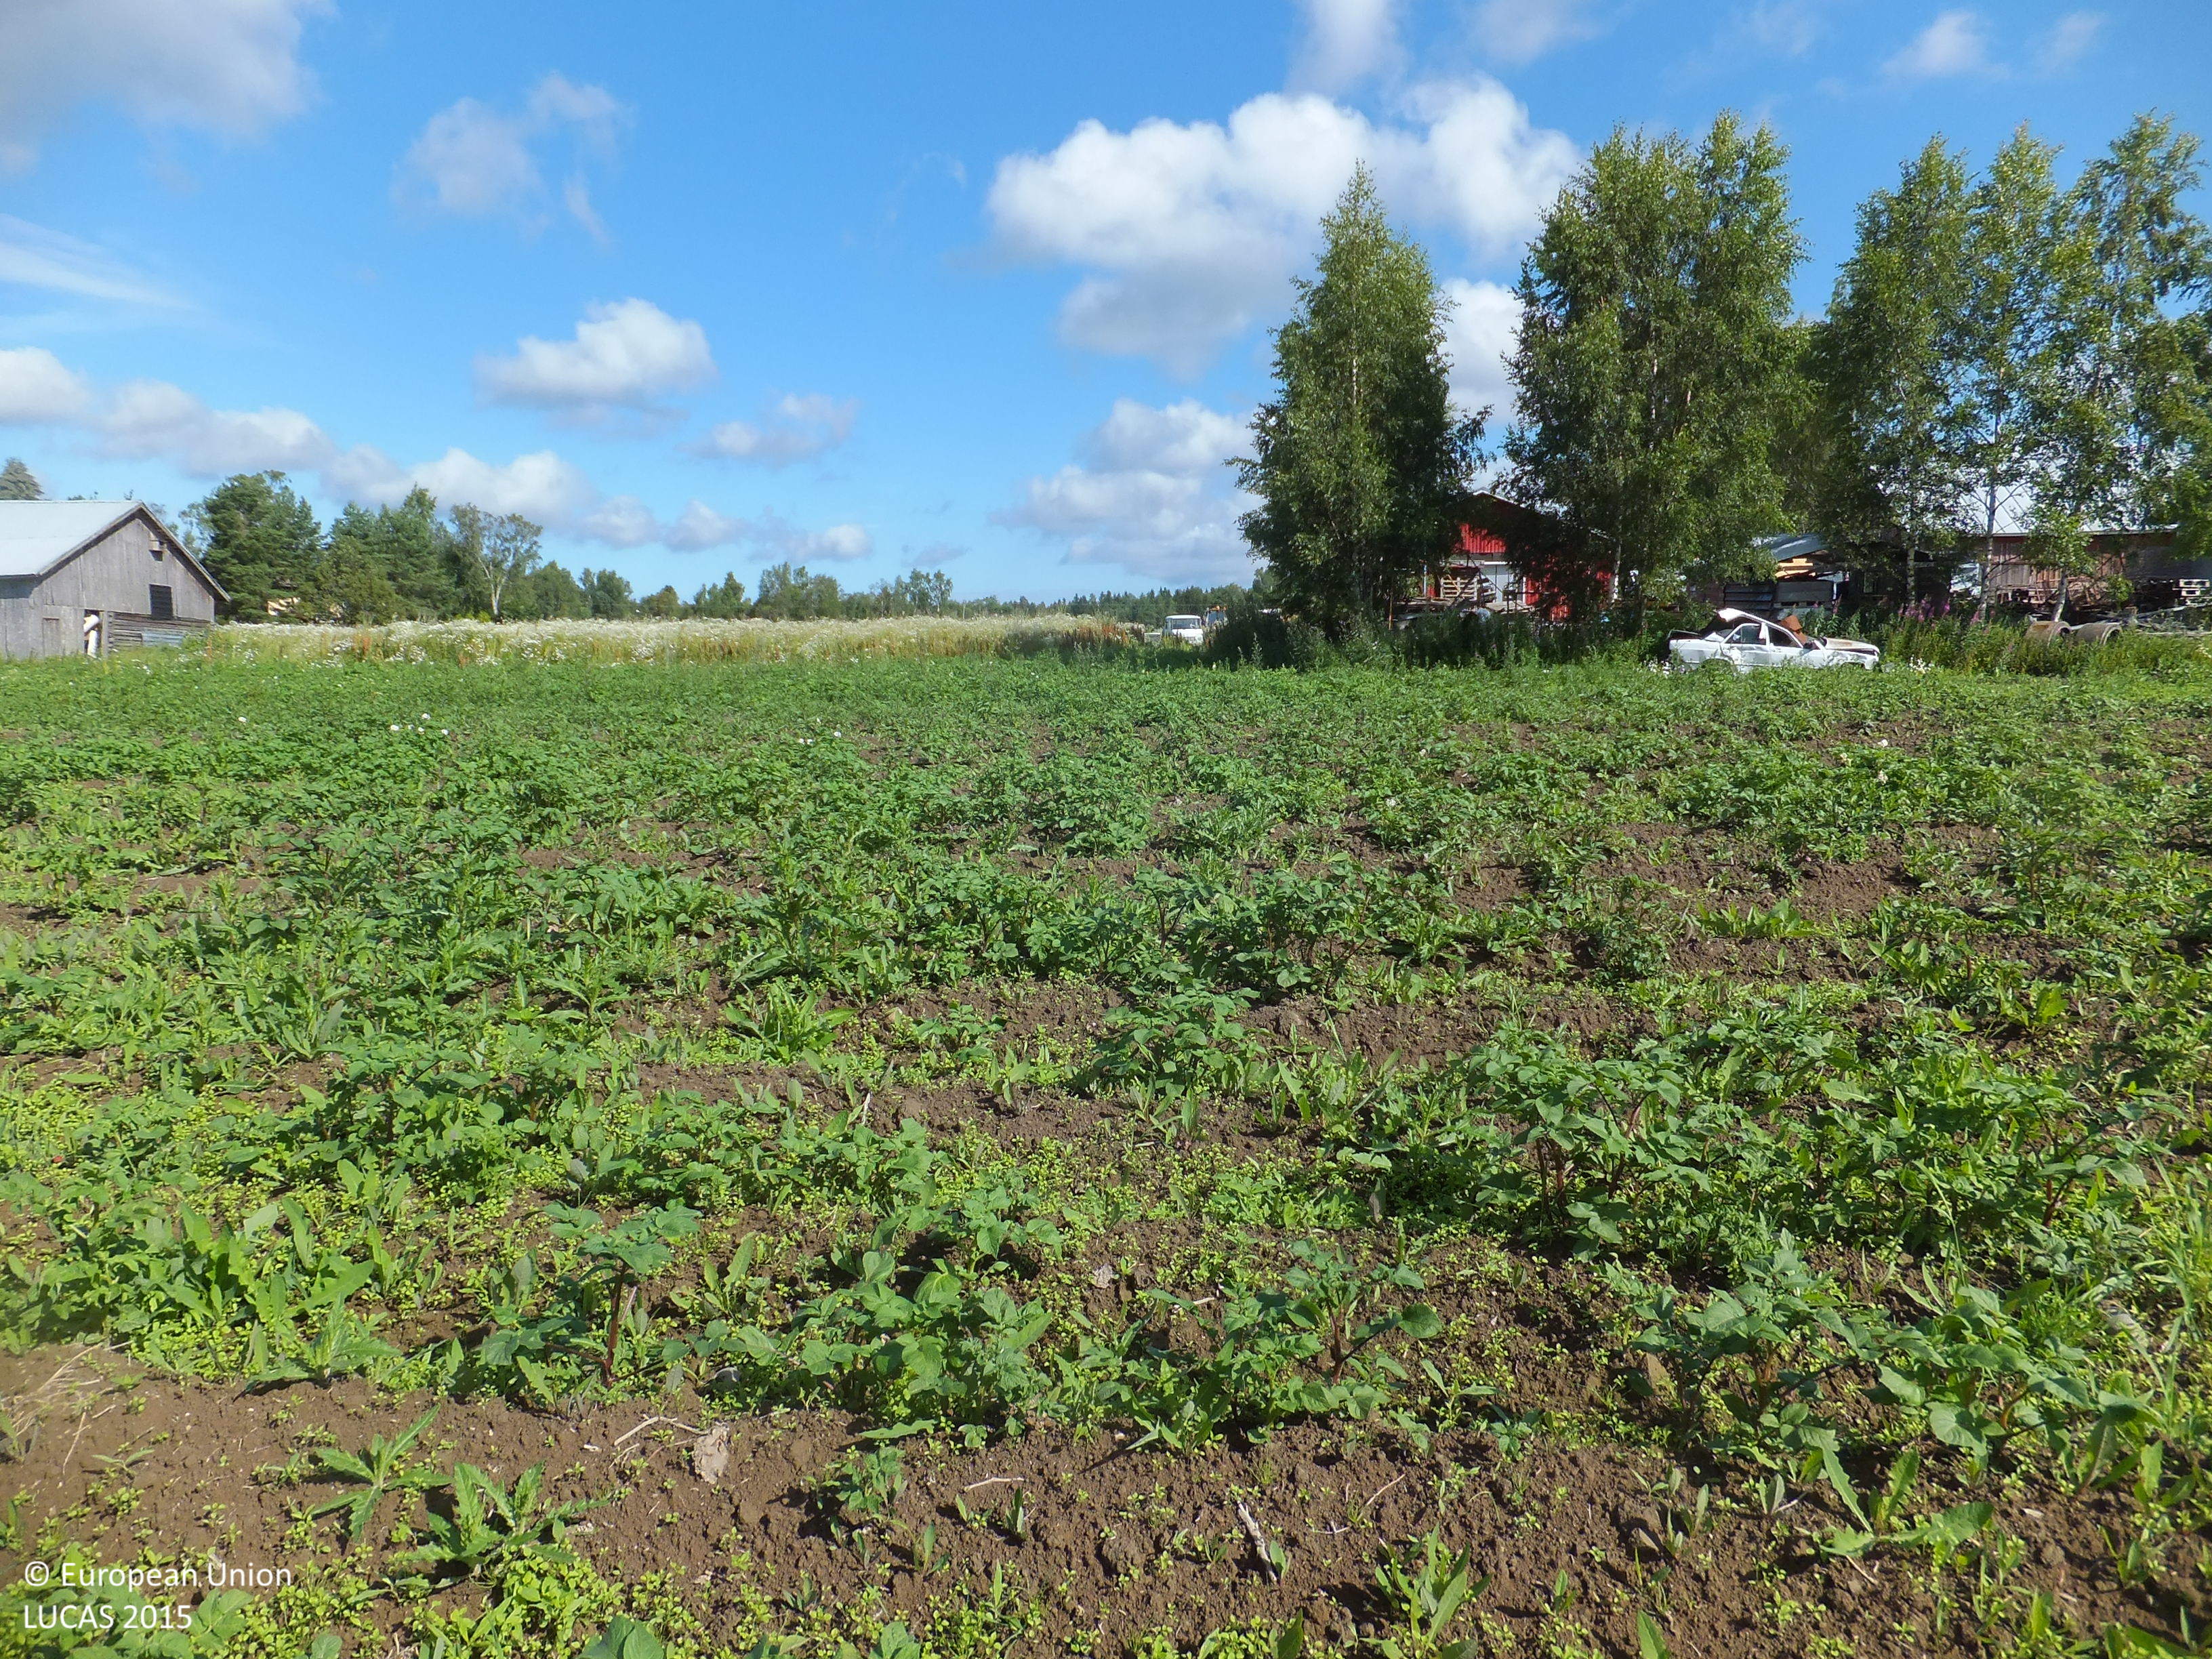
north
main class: Cropland
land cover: Potatoes
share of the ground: 25 - 50 %
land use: Agriculture (excluding fallow land and kitchen gardens)
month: July
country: FI
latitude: 63.1836
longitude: 21.6227
